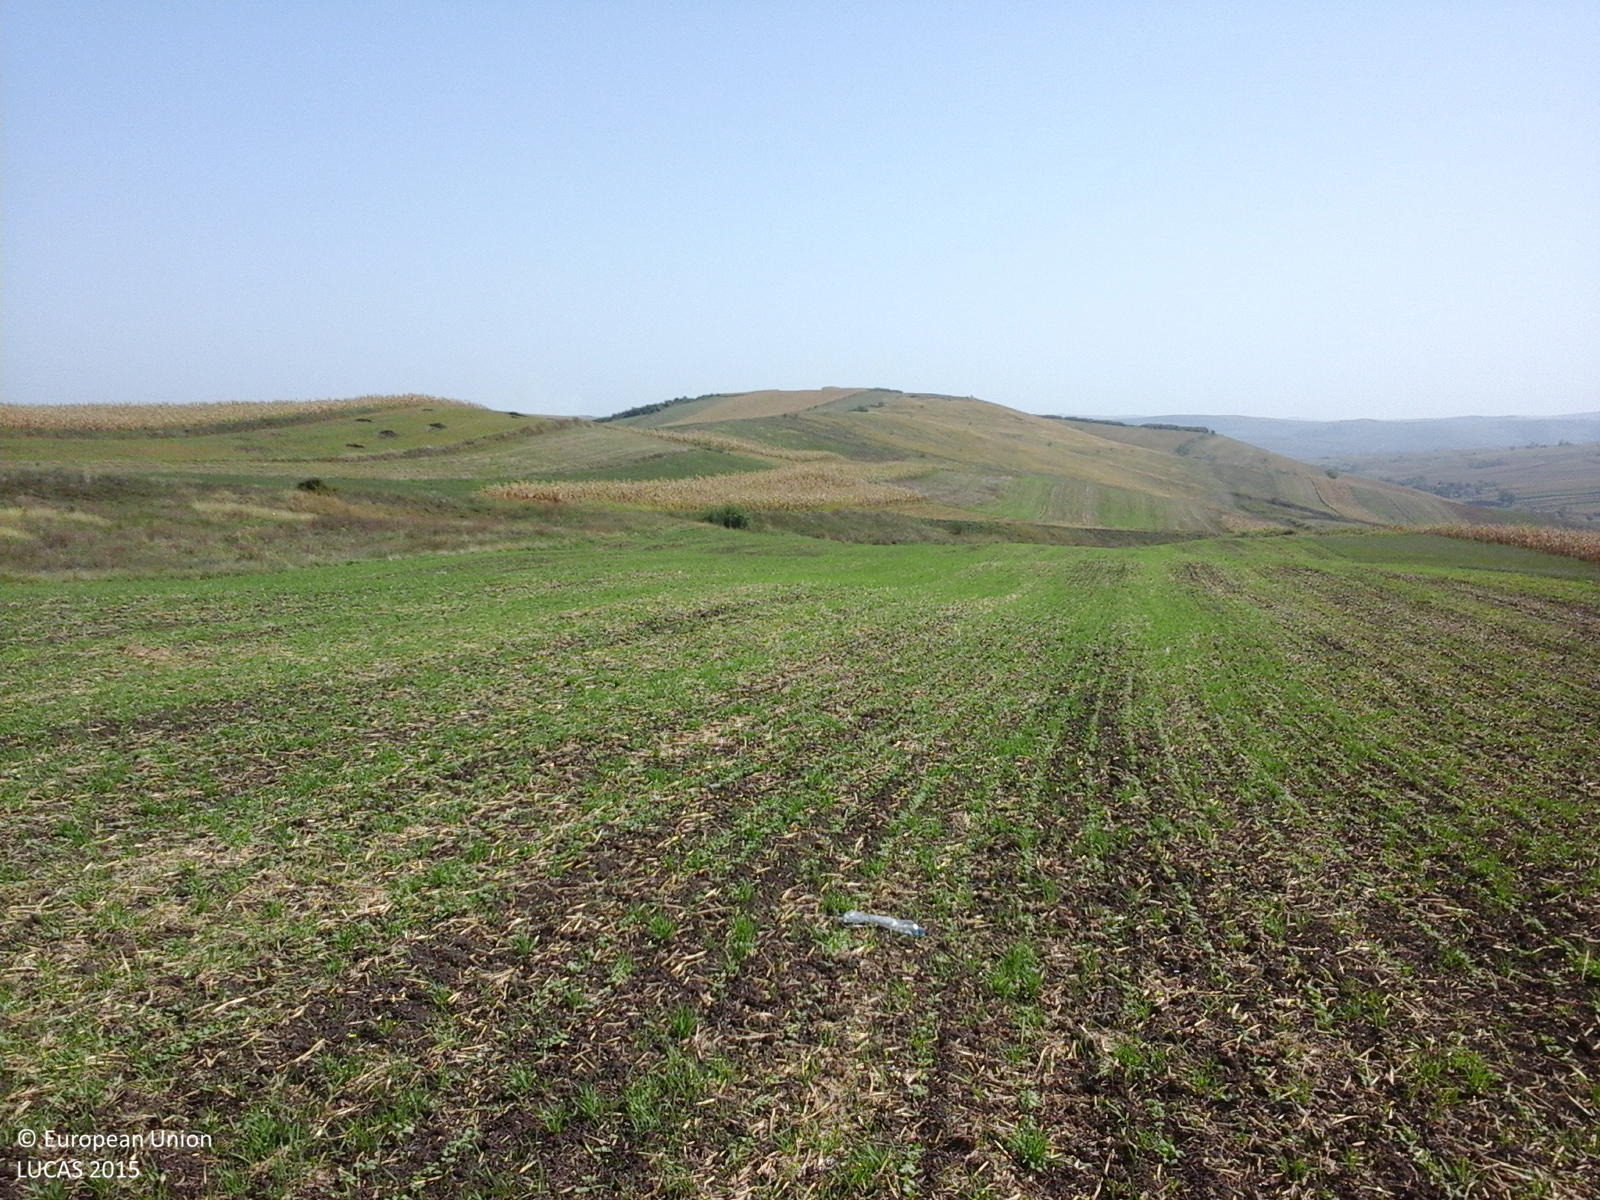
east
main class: Cropland
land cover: Rye
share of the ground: 25 - 50 %
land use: Agriculture (excluding fallow land and kitchen gardens)
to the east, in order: Rye; Grassland without tree/shrub cover; Maize; Lucerne; Rye
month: September
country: RO
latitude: 46.6464
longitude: 24.0189
